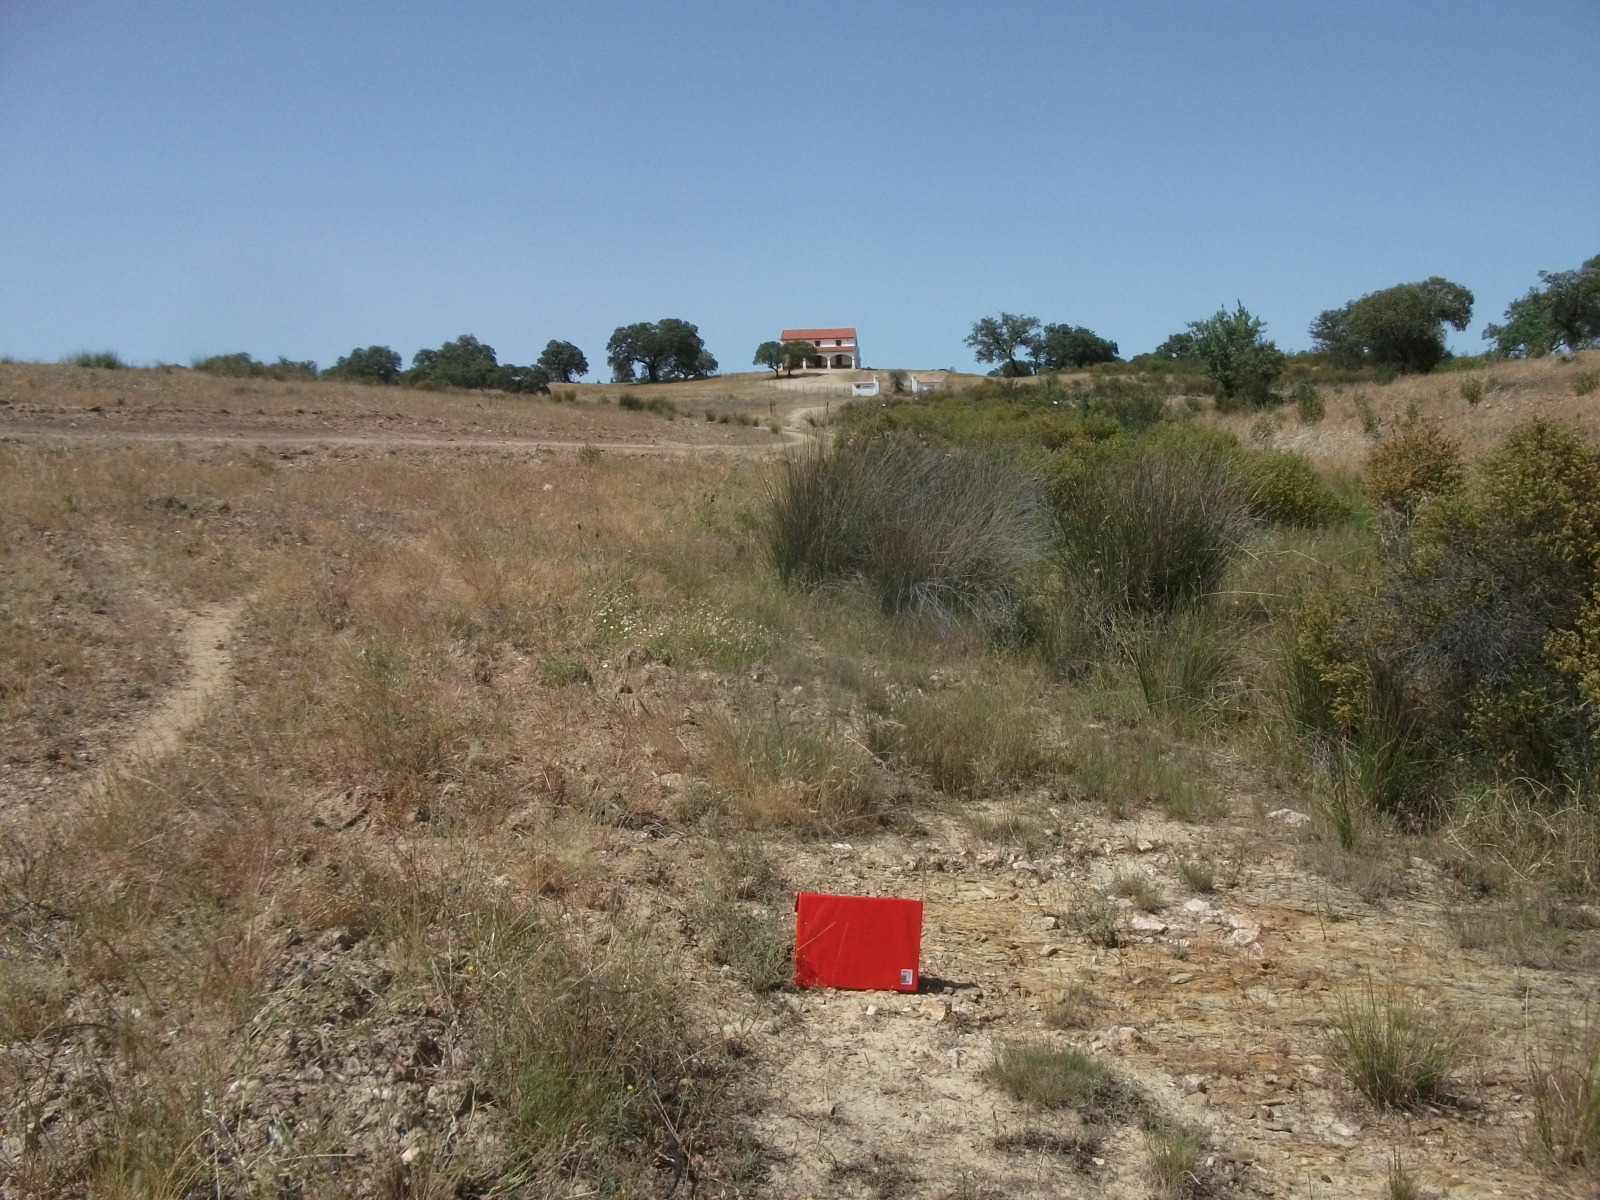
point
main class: Shrubland
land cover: Shrubland without tree cover
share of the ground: 50 - 75 %
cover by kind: herbaceous plants 55 %, shrubs 45 %
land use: Agriculture (excluding fallow land and kitchen gardens)
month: May
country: ES
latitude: 37.7331
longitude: -7.1285
